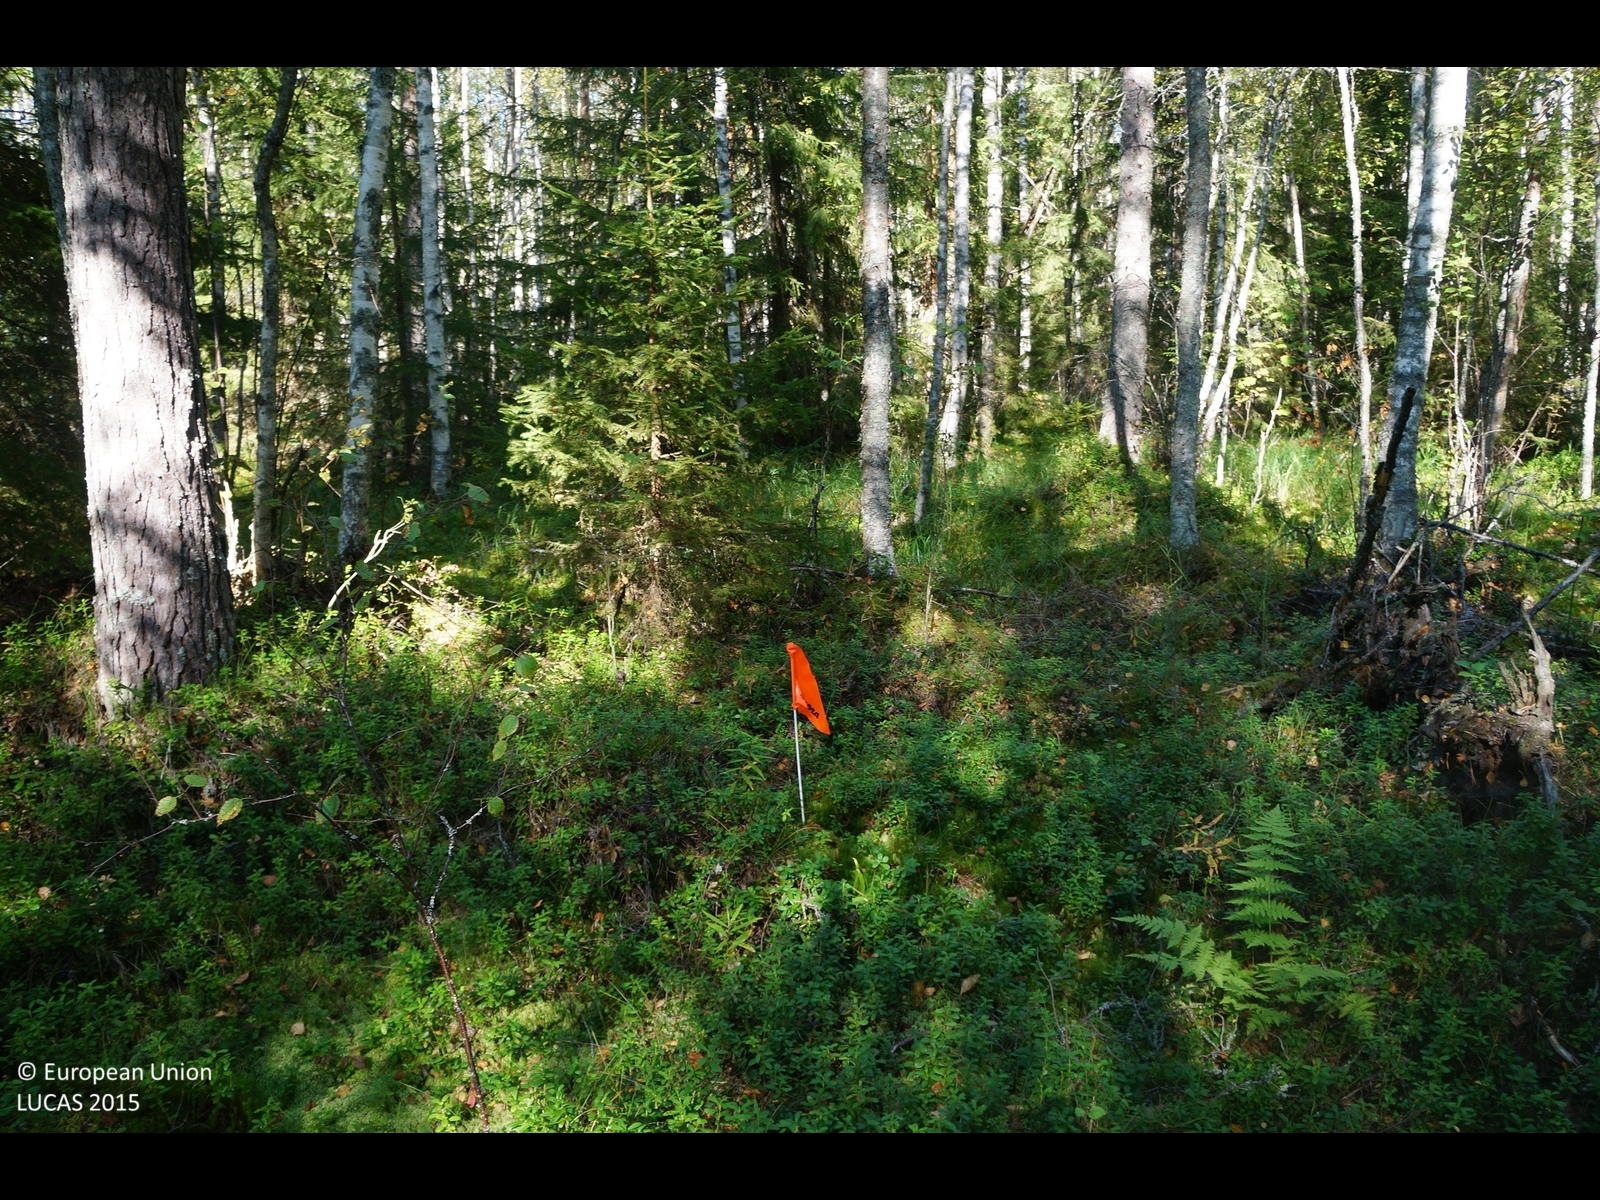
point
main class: Woodland
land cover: Other mixed woodland
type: boreal forest
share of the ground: 50 - 75 %
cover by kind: coniferous forest trees 50 %, broadleaved forest trees 20 %, shrubs 15 %, lichens and mosses 10 %, herbaceous plants 5 %
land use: Forestry
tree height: > 5 m
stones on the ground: < 10 %
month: August
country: FI
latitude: 64.1271
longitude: 25.1416
